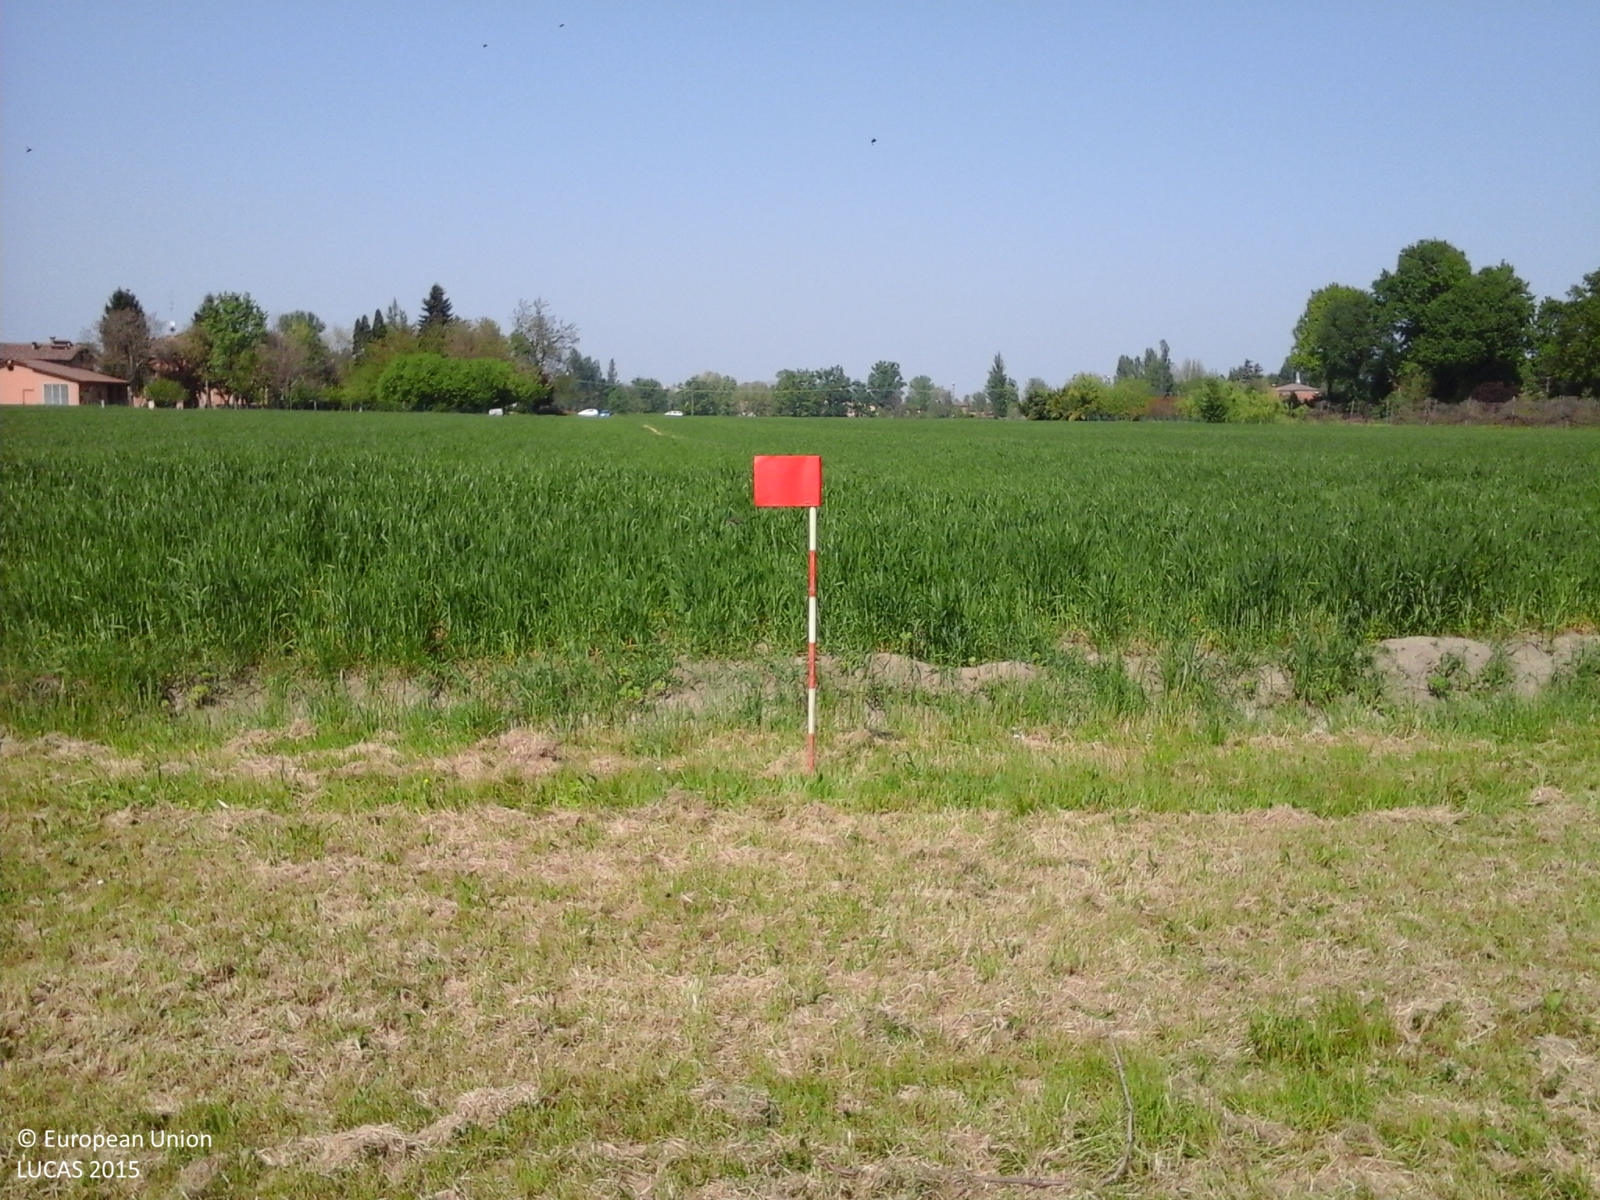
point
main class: Grassland
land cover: Spontaneously vegetated surfaces
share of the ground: > 75 %
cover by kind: herbaceous plants 100 %
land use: Agriculture (excluding fallow land and kitchen gardens)
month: April
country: IT
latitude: 44.6172
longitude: 10.8928
